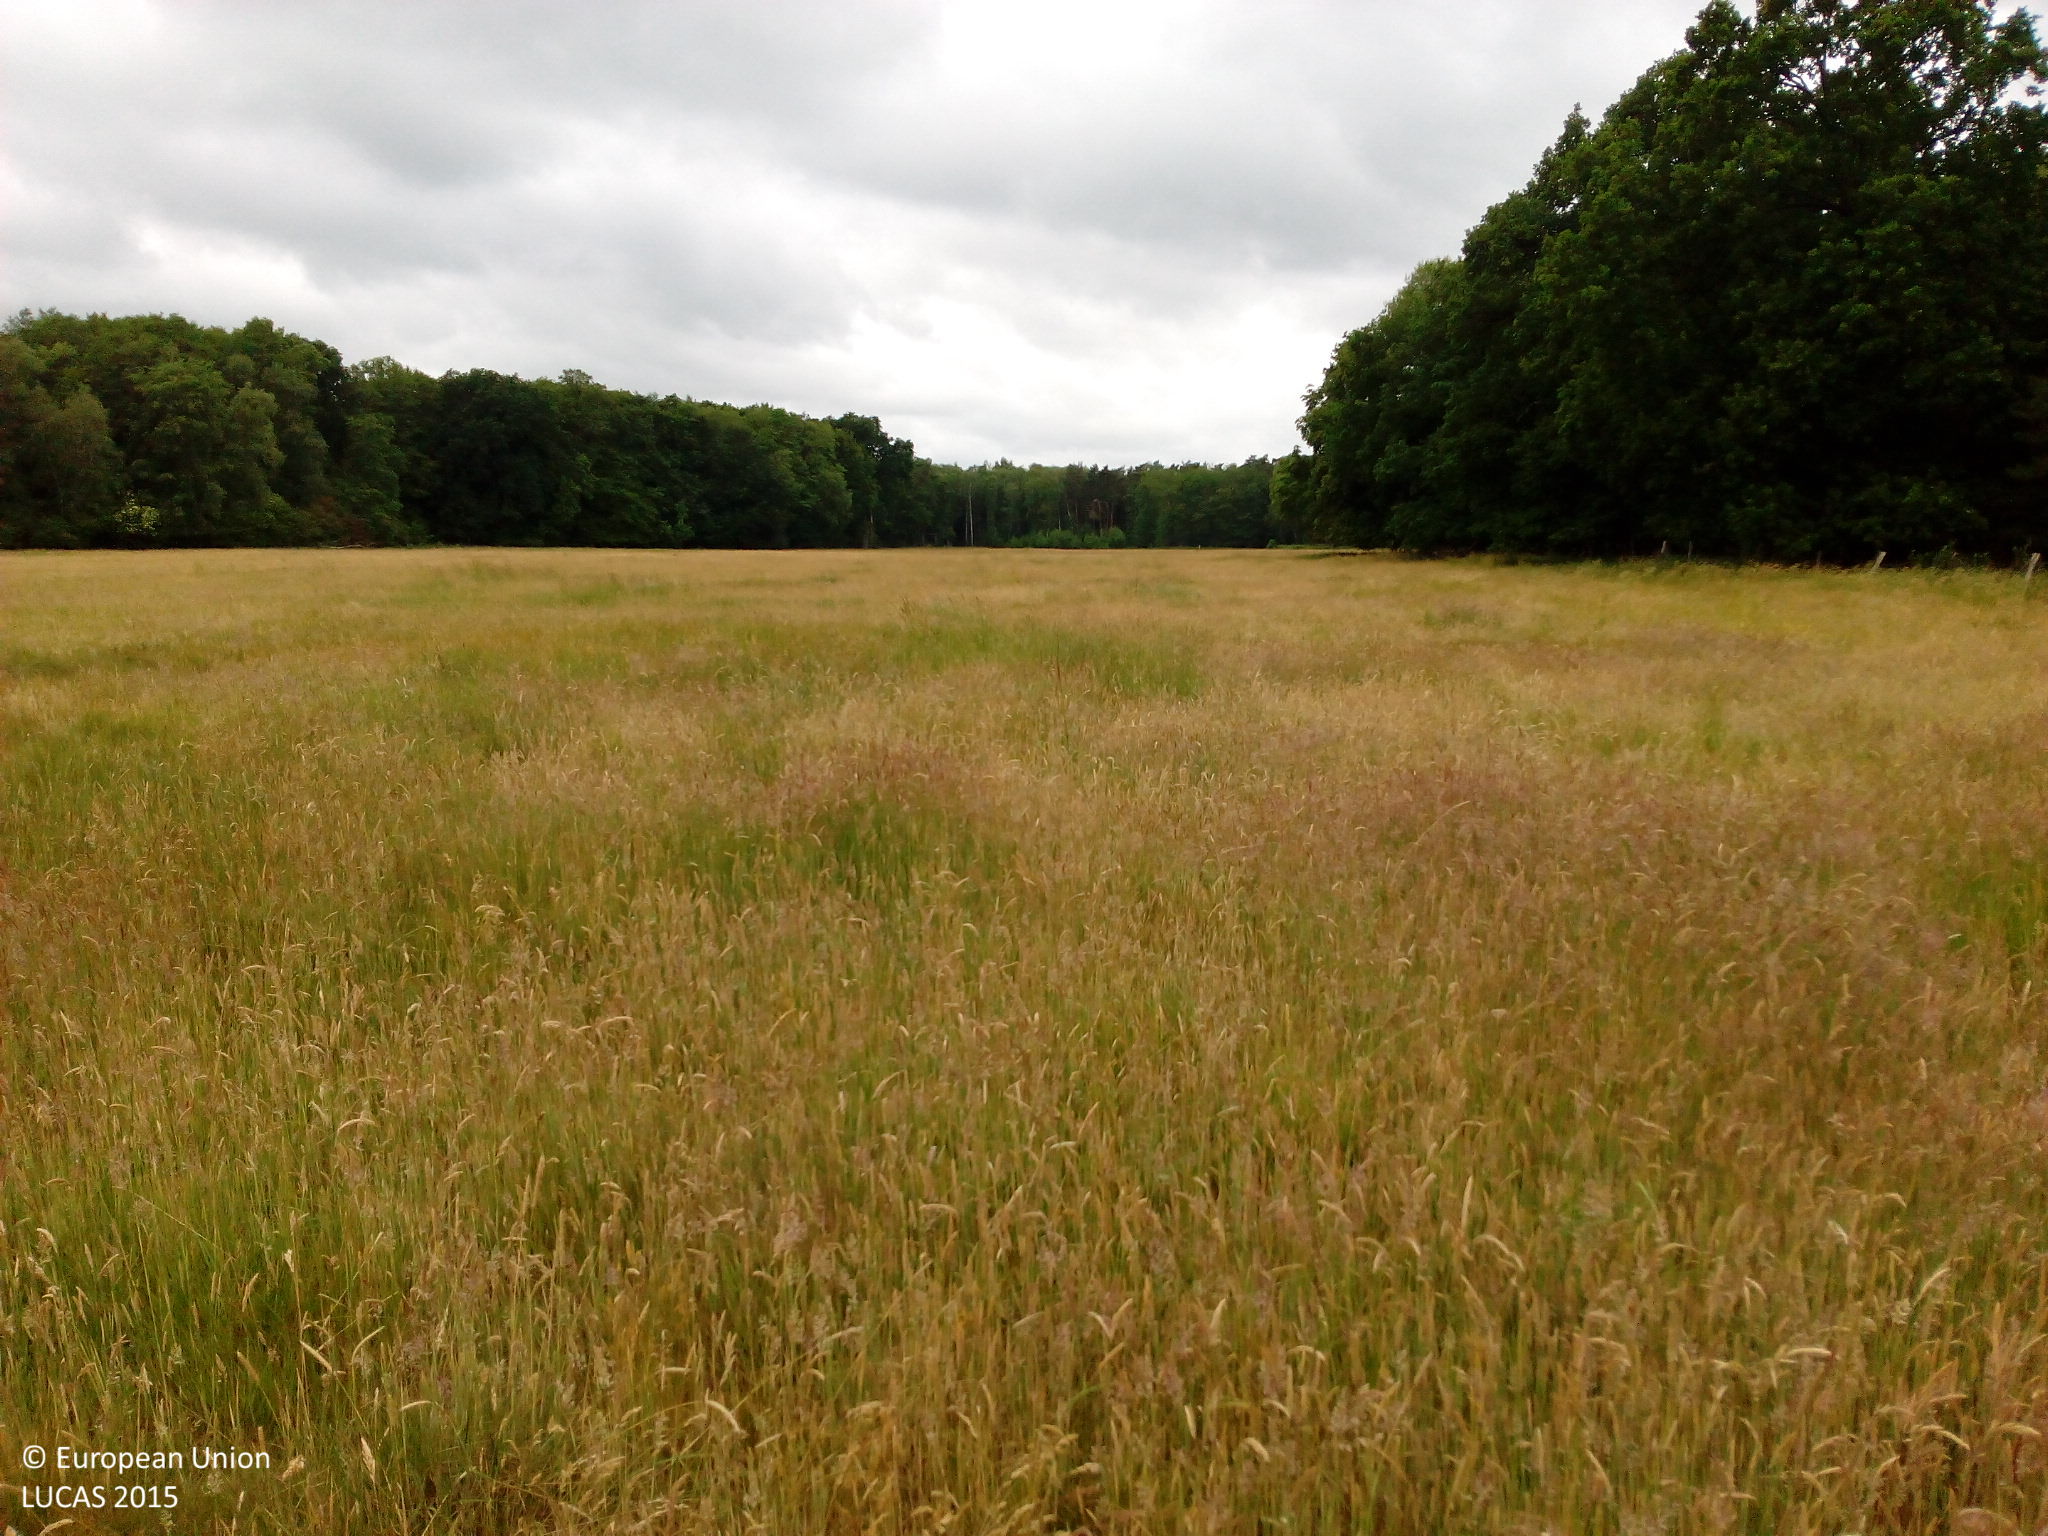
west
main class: Grassland
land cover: Spontaneously vegetated surfaces
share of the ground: > 75 %
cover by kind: herbaceous plants 100 %
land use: Semi-natural and natural areas not in use
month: June
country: DE
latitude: 52.6043
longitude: 12.4359
